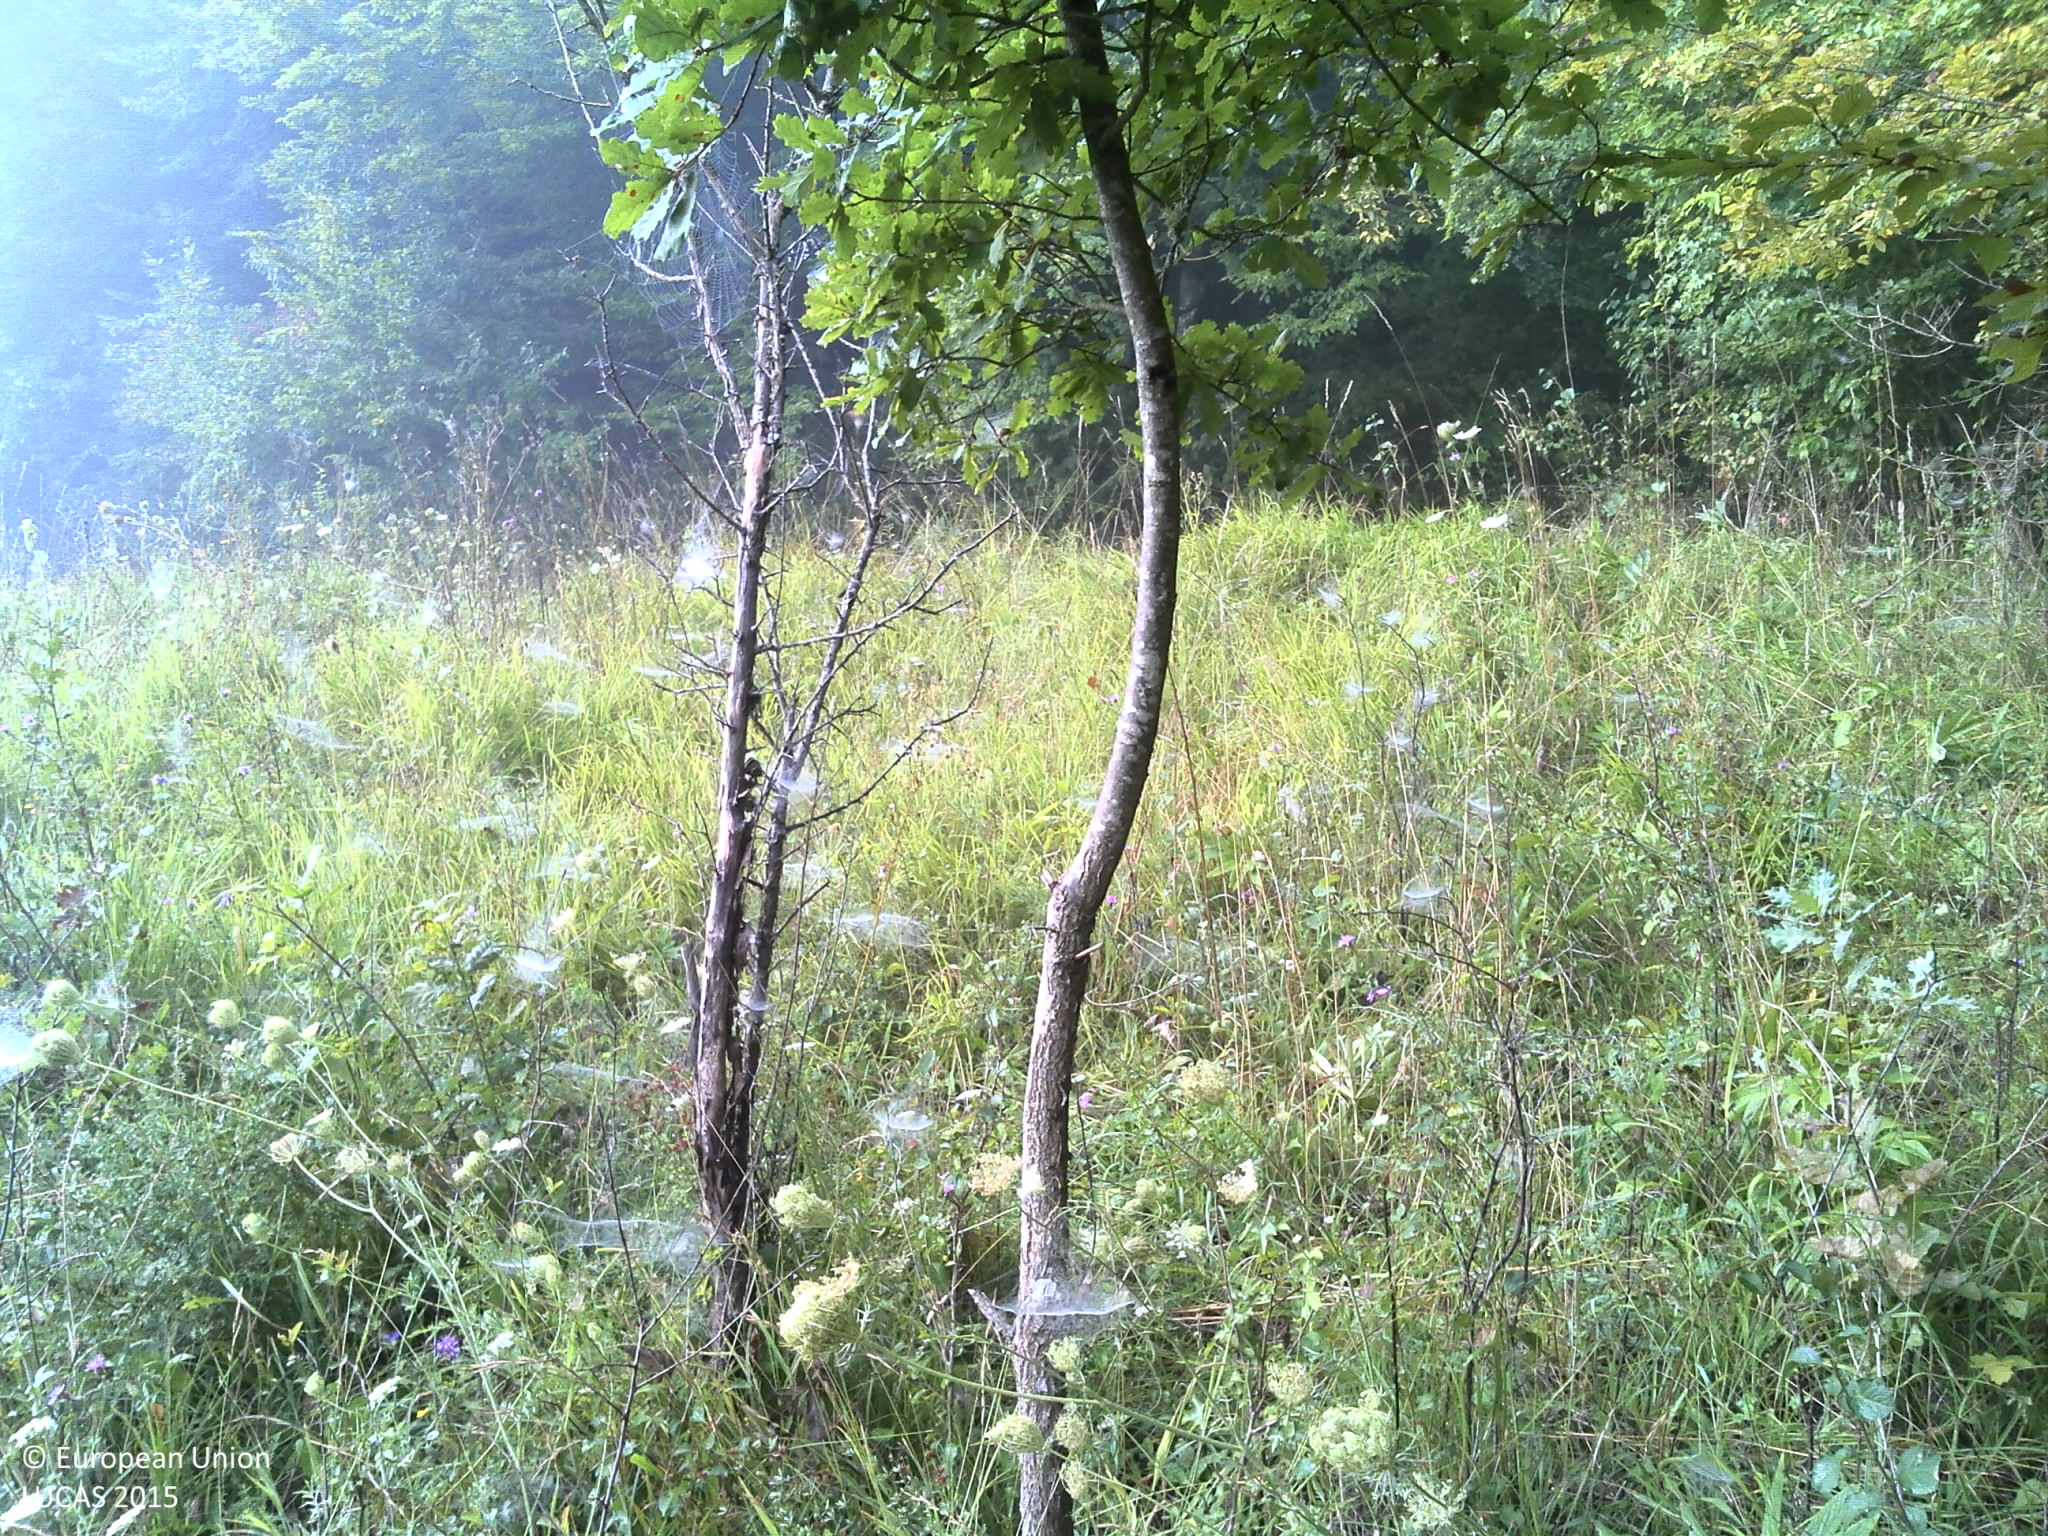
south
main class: Grassland
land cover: Spontaneously vegetated surfaces
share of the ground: > 75 %
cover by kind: herbaceous plants 95 %, shrubs 5 %
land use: Semi-natural and natural areas not in use
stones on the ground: < 10 %
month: August
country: HR
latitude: 45.1689
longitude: 16.3457
